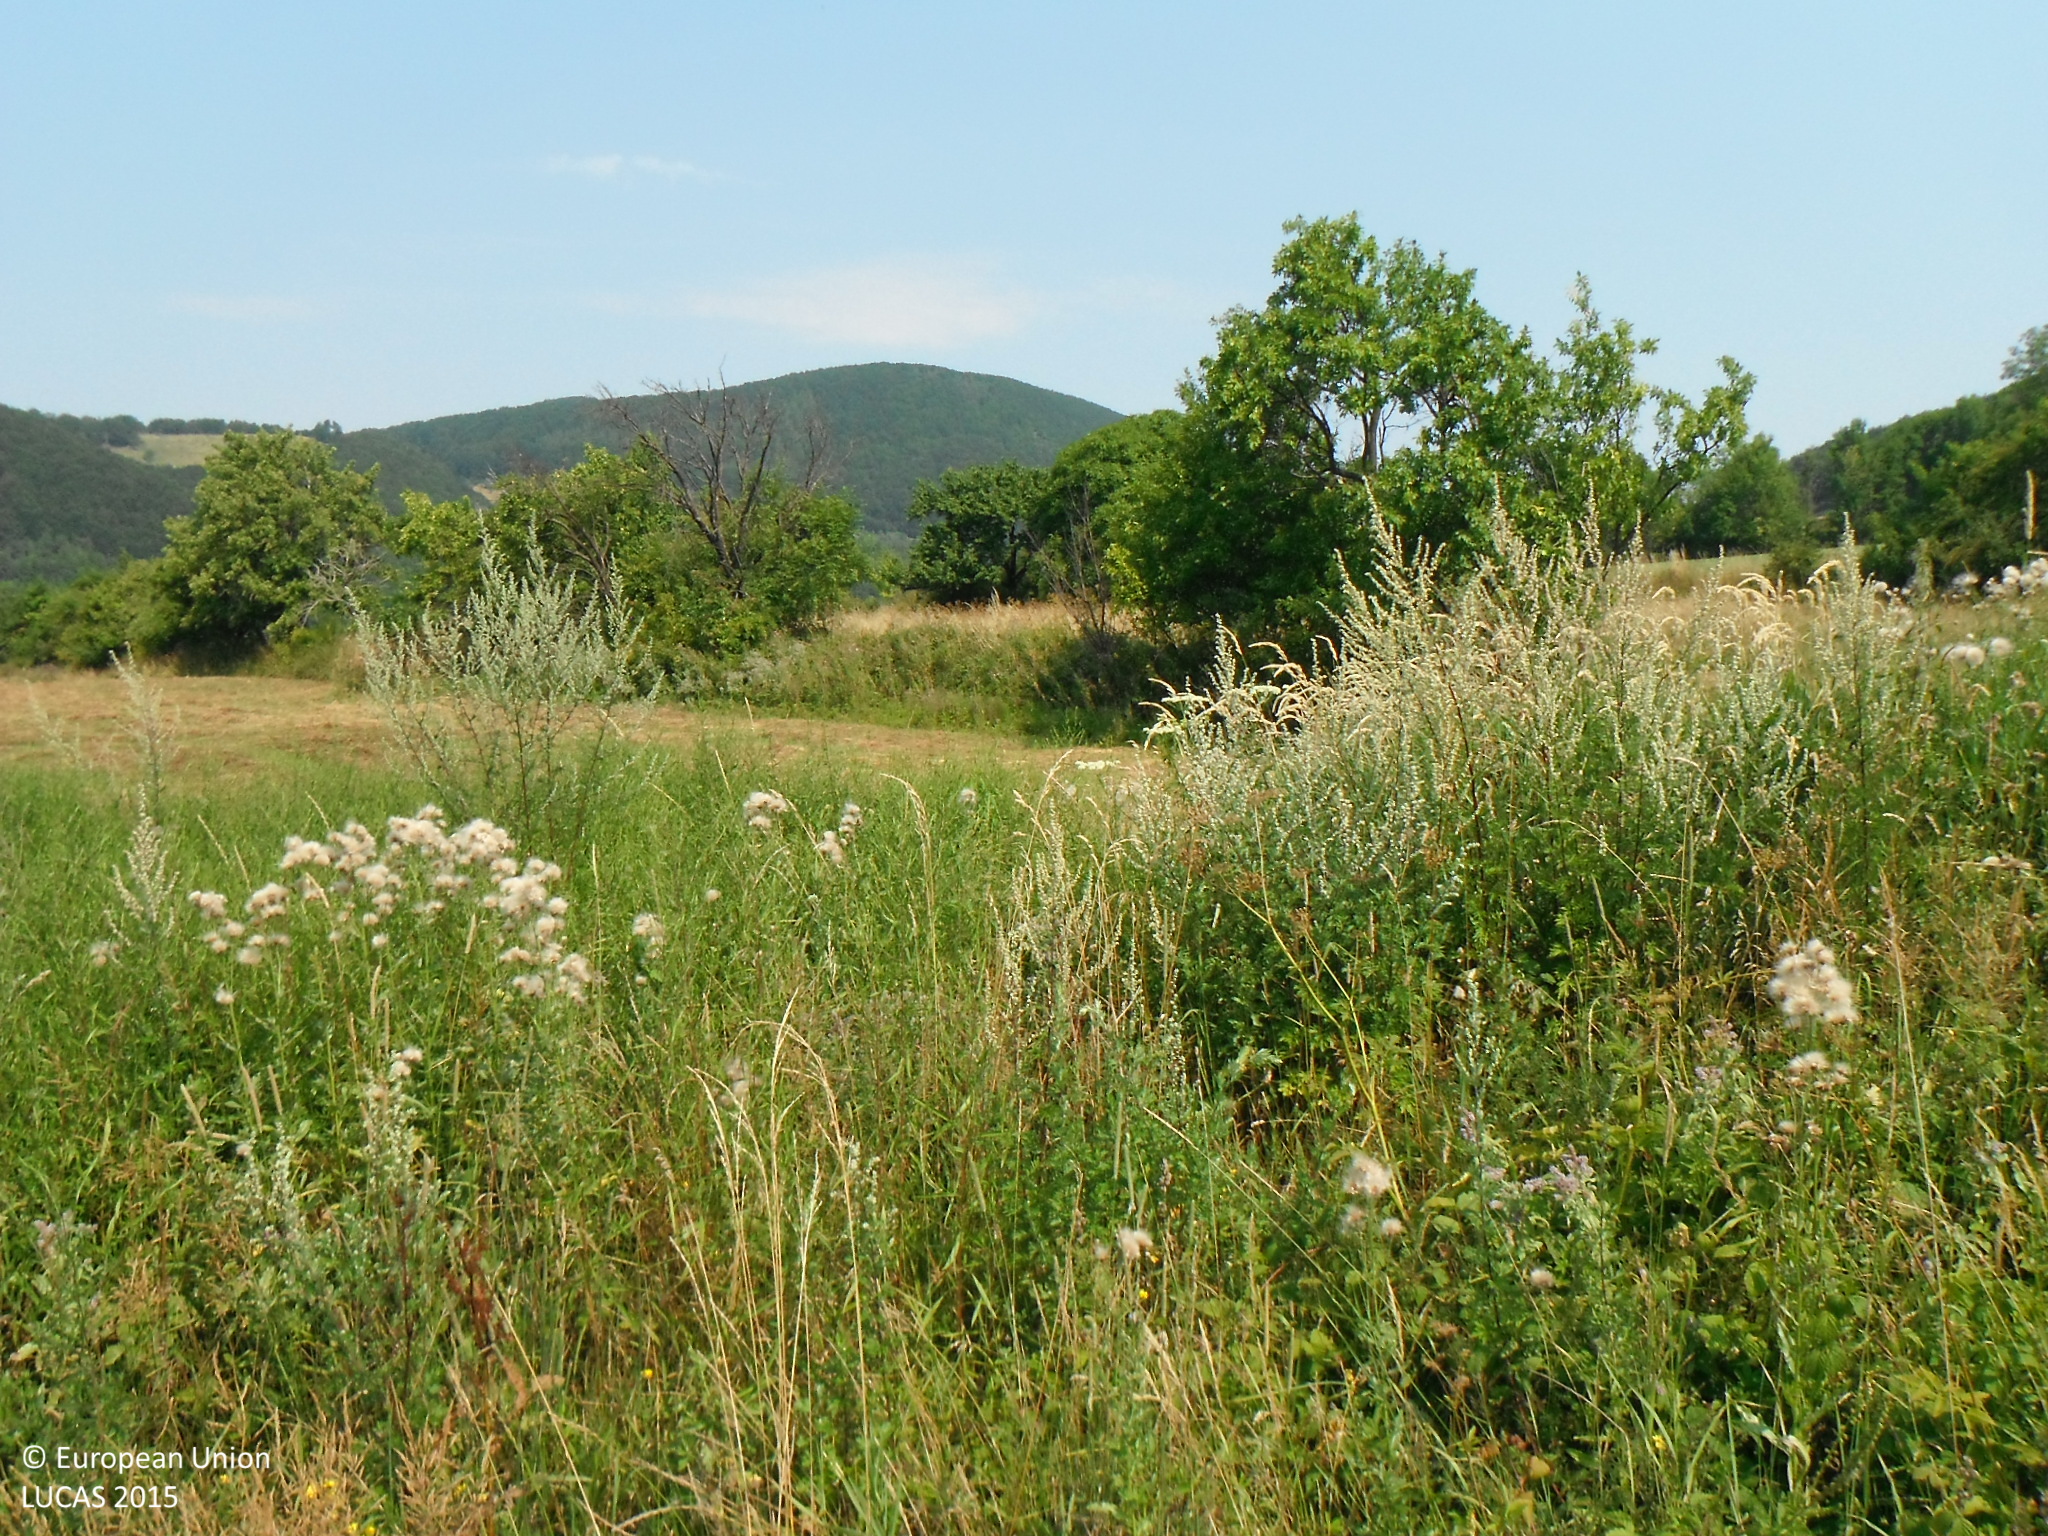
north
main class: Grassland
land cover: Grassland without tree/shrub cover
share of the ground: > 75 %
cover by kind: herbaceous plants 100 %
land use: Agriculture (excluding fallow land and kitchen gardens)
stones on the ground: 10 - 25 %
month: August
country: SK
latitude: 48.9485
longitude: 18.4423
